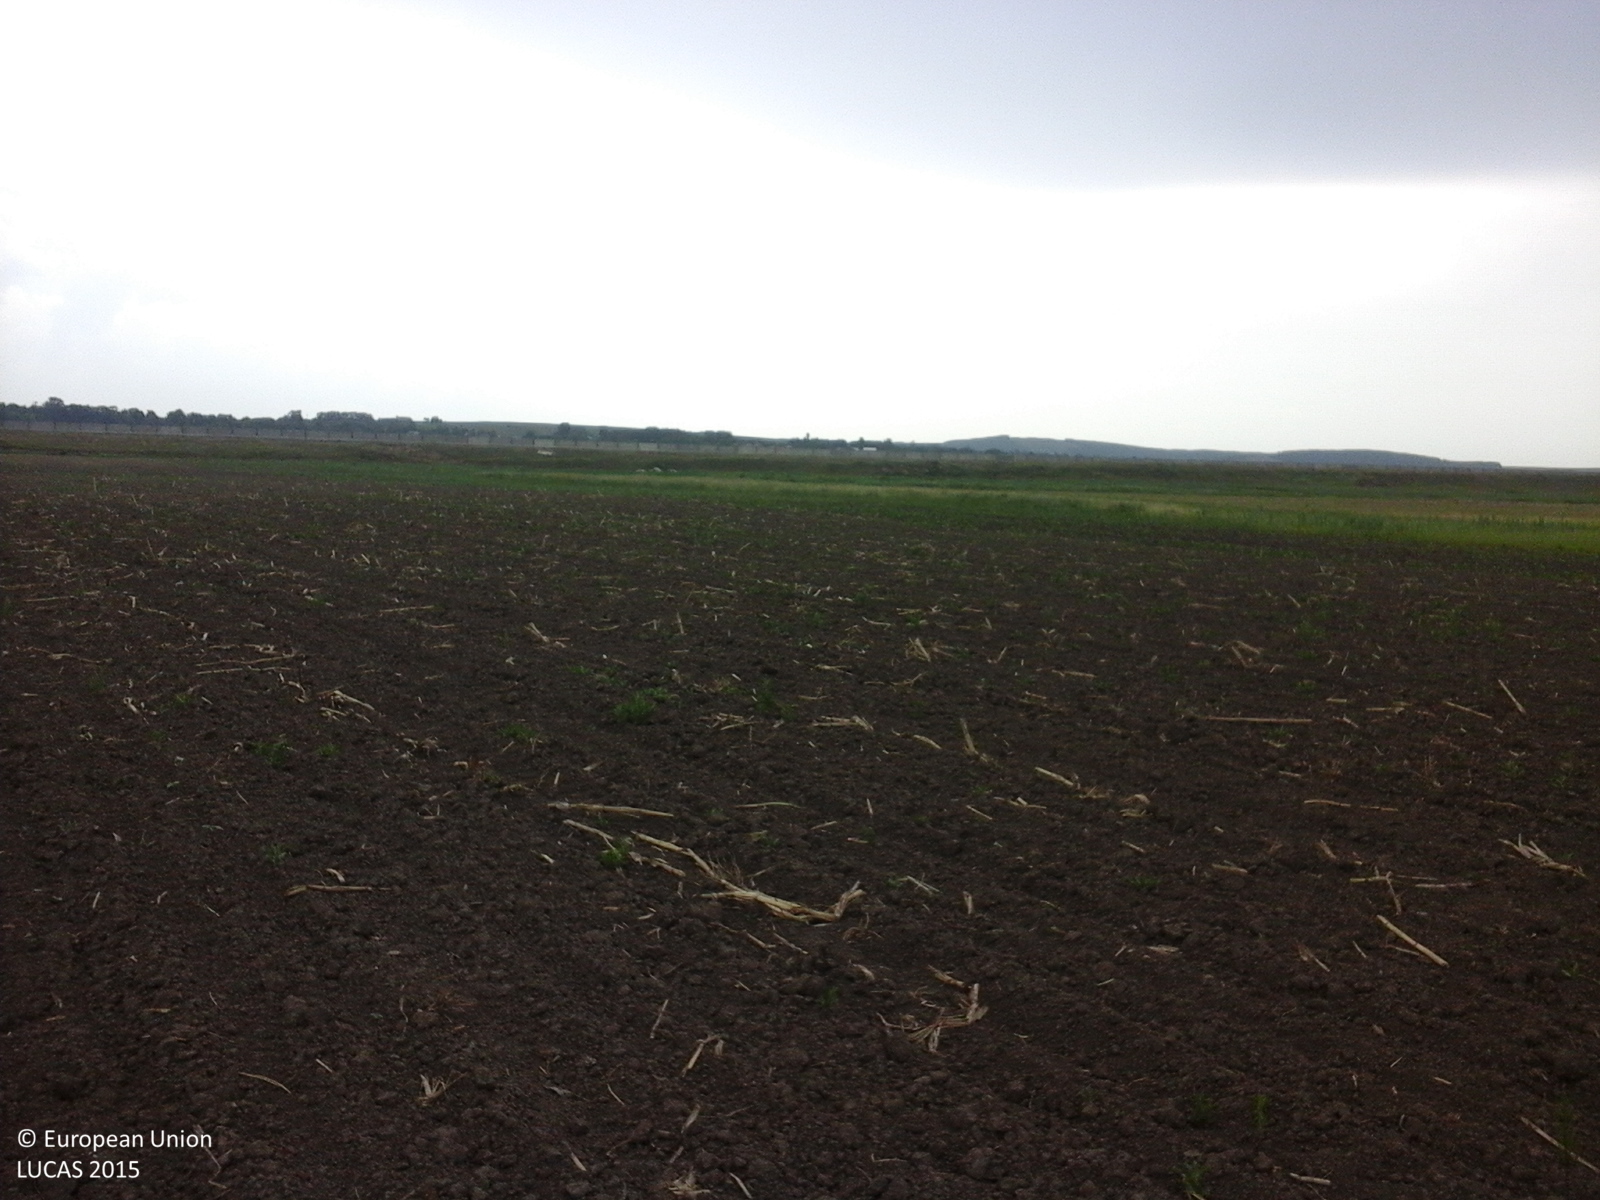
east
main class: Cropland
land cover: Sunflower
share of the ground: < 10 %
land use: Agriculture (excluding fallow land and kitchen gardens)
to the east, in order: Sunflower; Maize; Grassland without tree/shrub cover
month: June
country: RO
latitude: 47.3237
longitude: 26.6983
